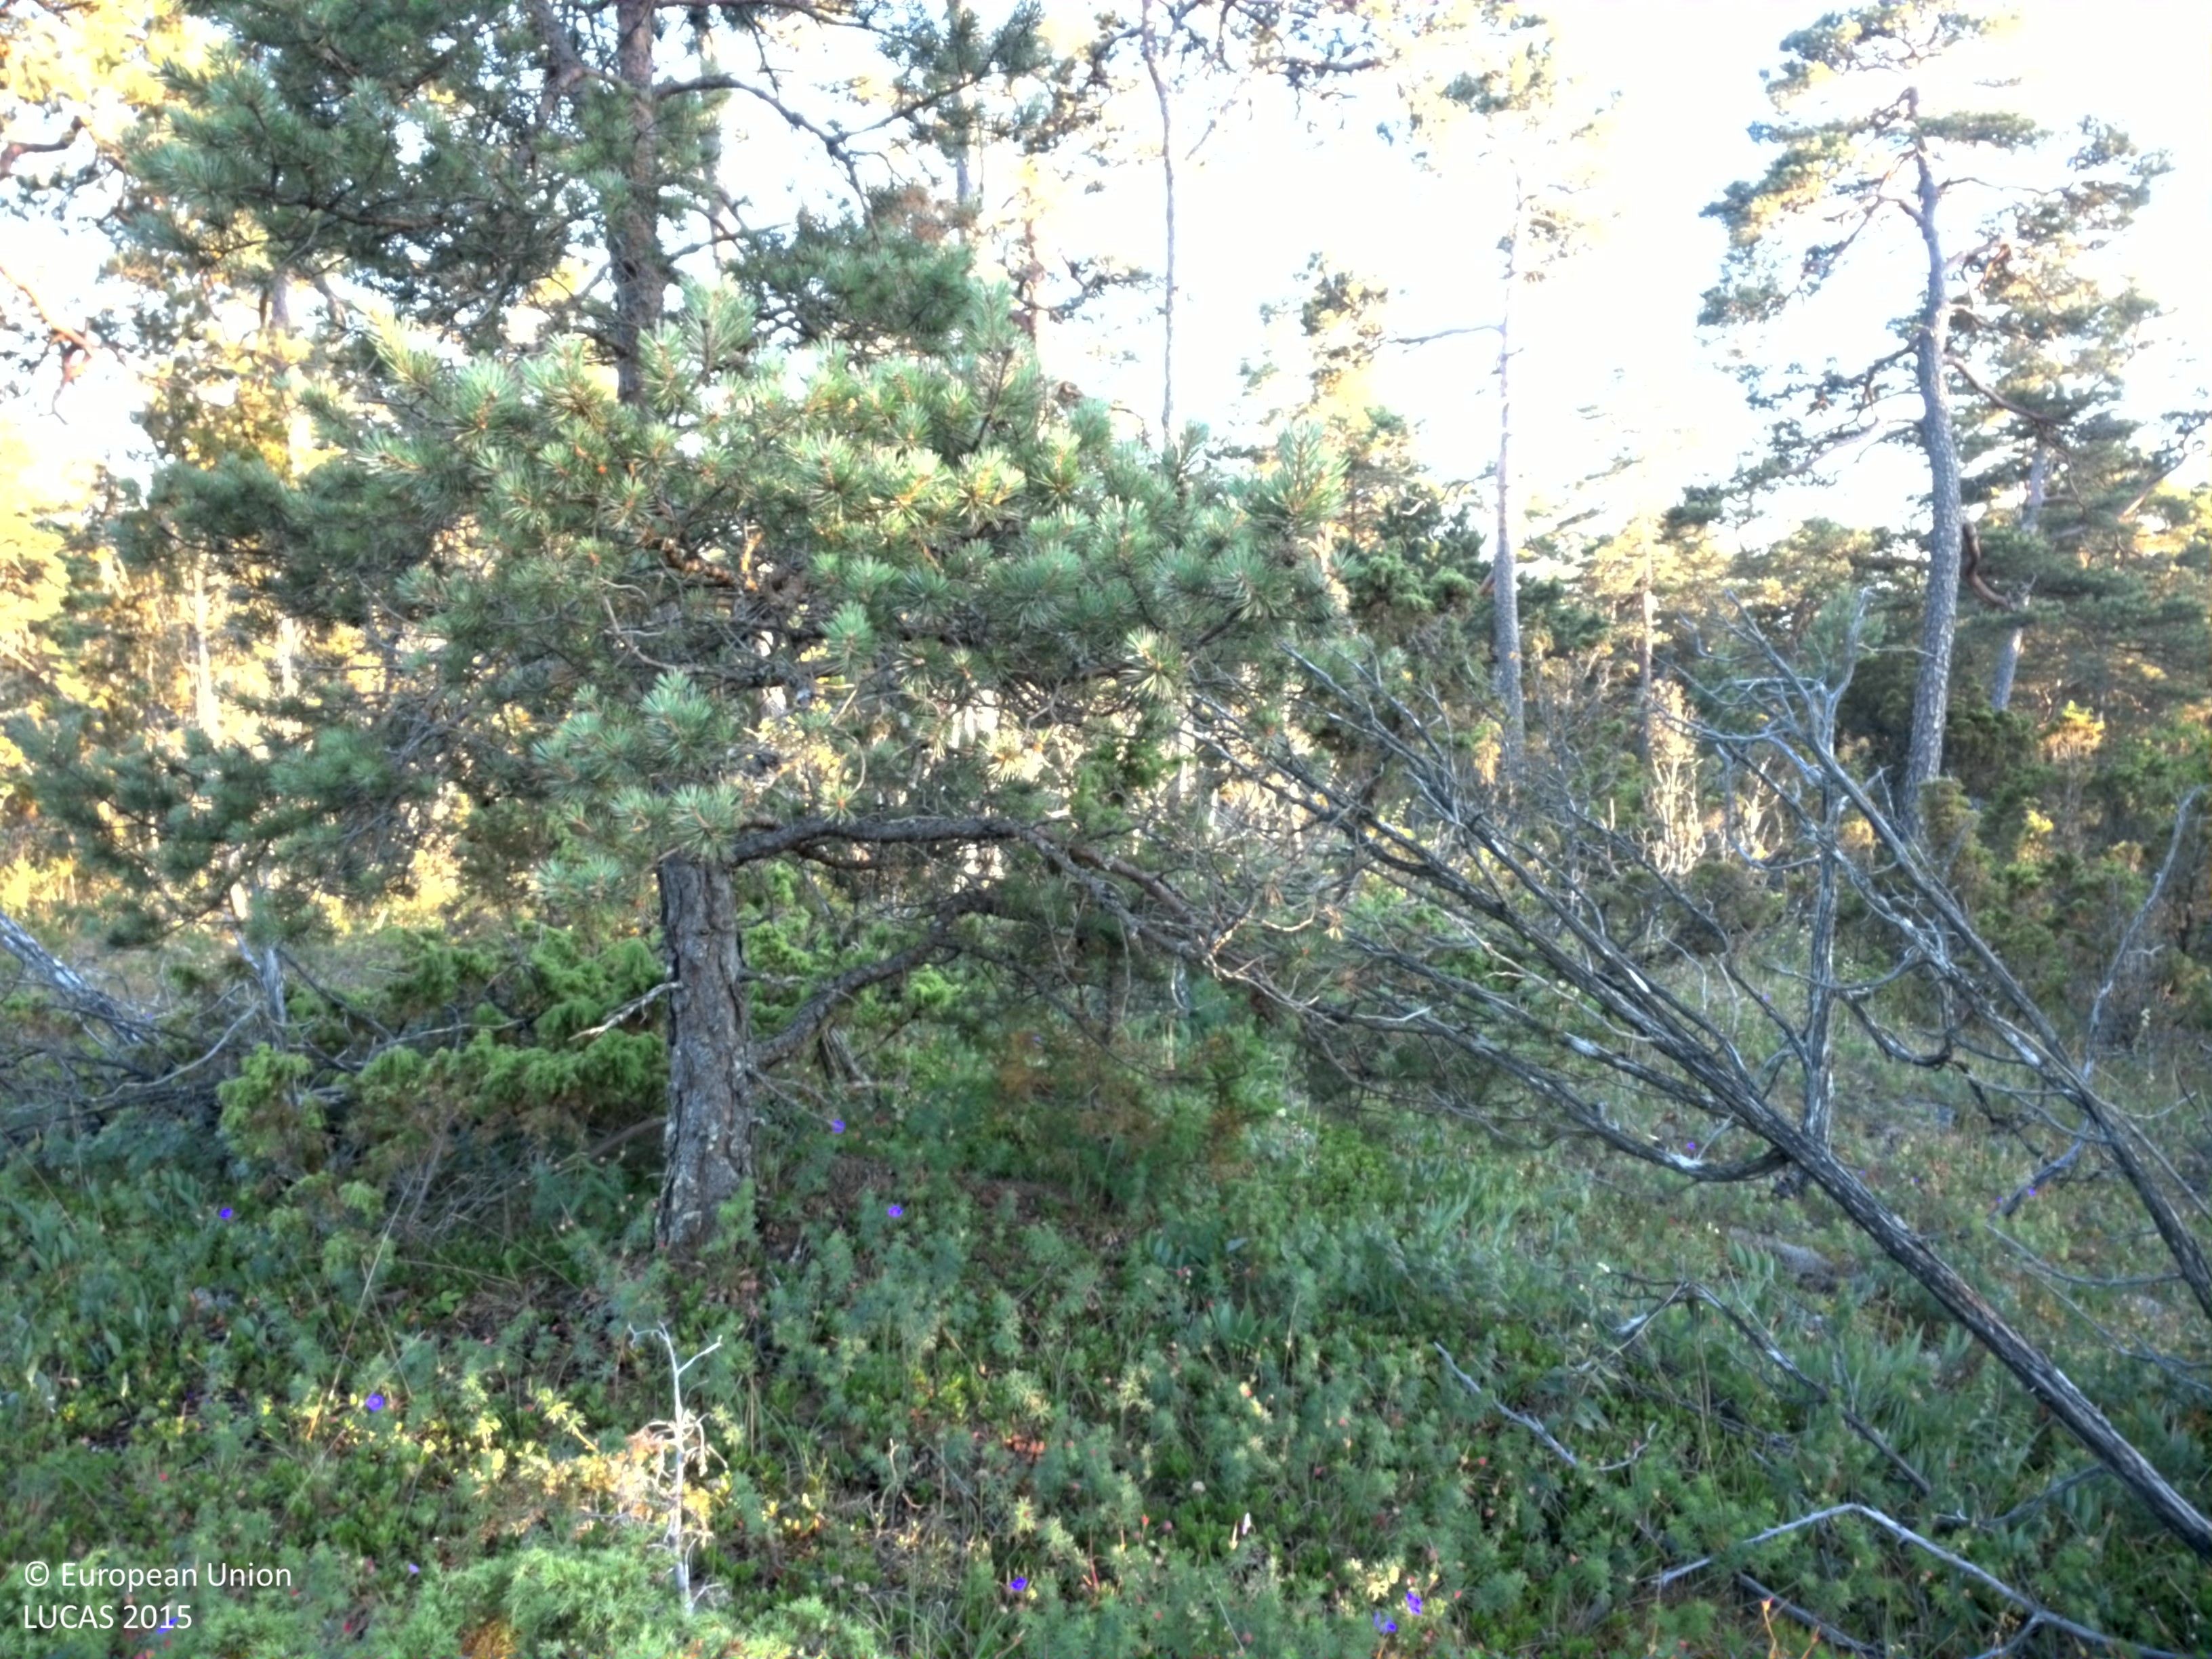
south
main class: Shrubland
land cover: Shrubland with sparse tree cover
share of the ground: > 75 %
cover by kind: shrubs 75 %, herbaceous plants 15 %, coniferous forest trees 5 %, lichens and mosses 5 %
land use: Semi-natural and natural areas not in use
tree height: > 5 m
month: July
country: SE
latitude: 57.3975
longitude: 18.6465
